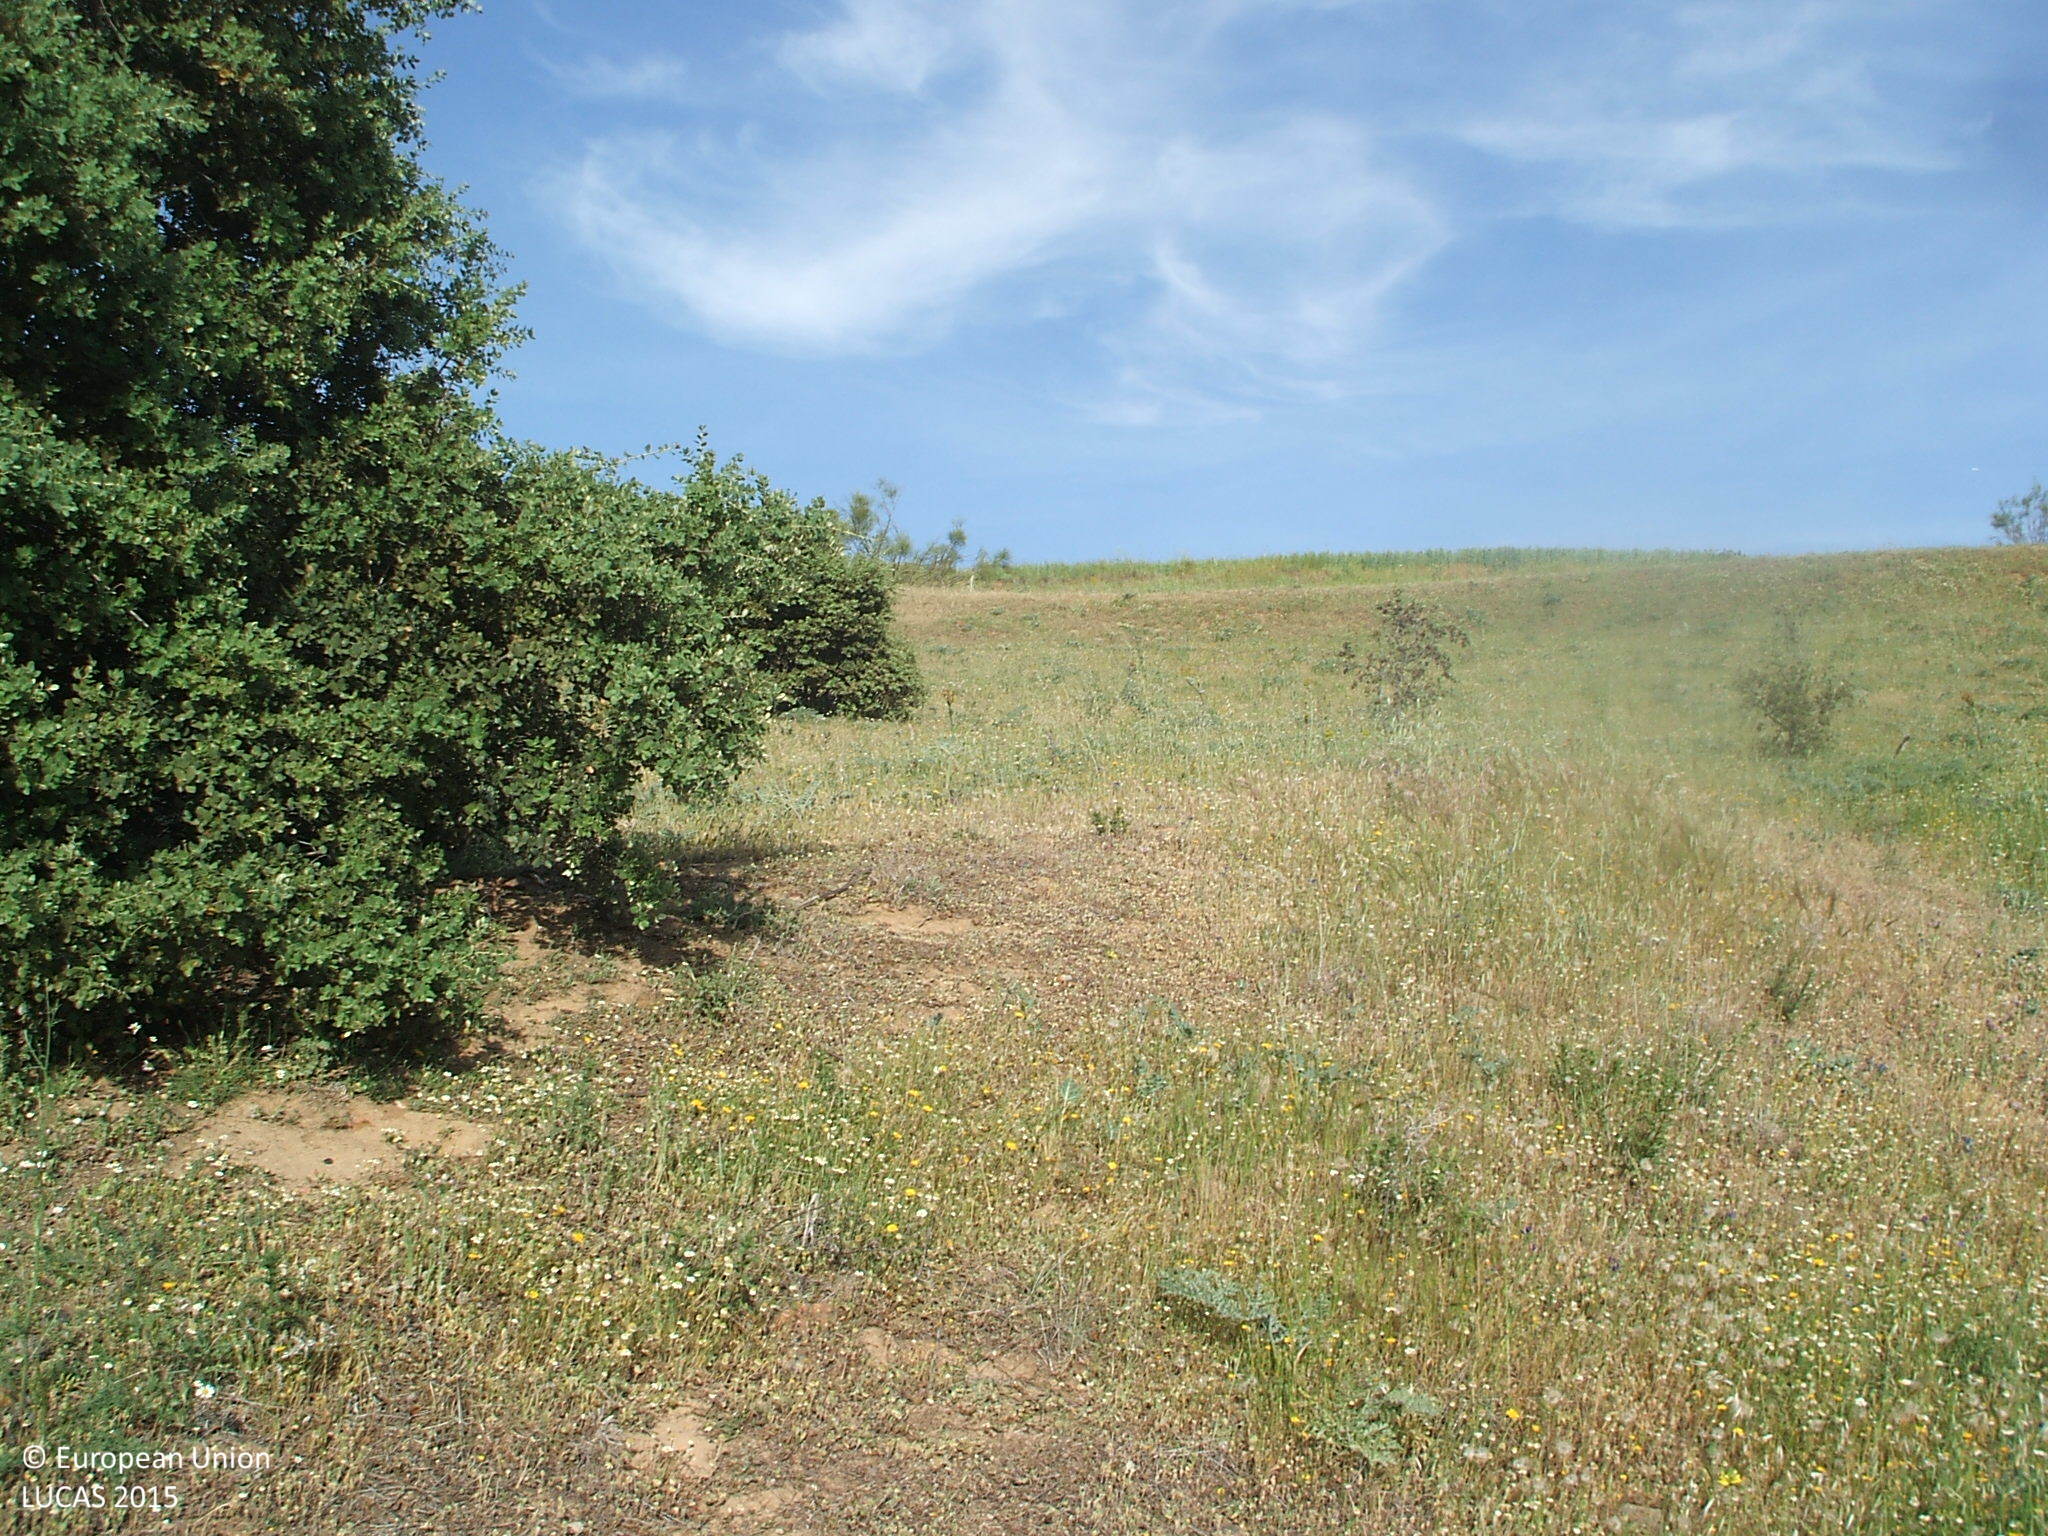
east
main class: Grassland
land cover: Grassland with sparse tree/shrub cover
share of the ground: > 75 %
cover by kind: herbaceous plants 95 %, broadleaved forest trees 5 %
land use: Abandoned areas
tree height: > 5 m
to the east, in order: Grassland with sparse tree/shrub cover; Common wheat
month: May
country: ES
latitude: 40.6921
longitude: -3.4451
